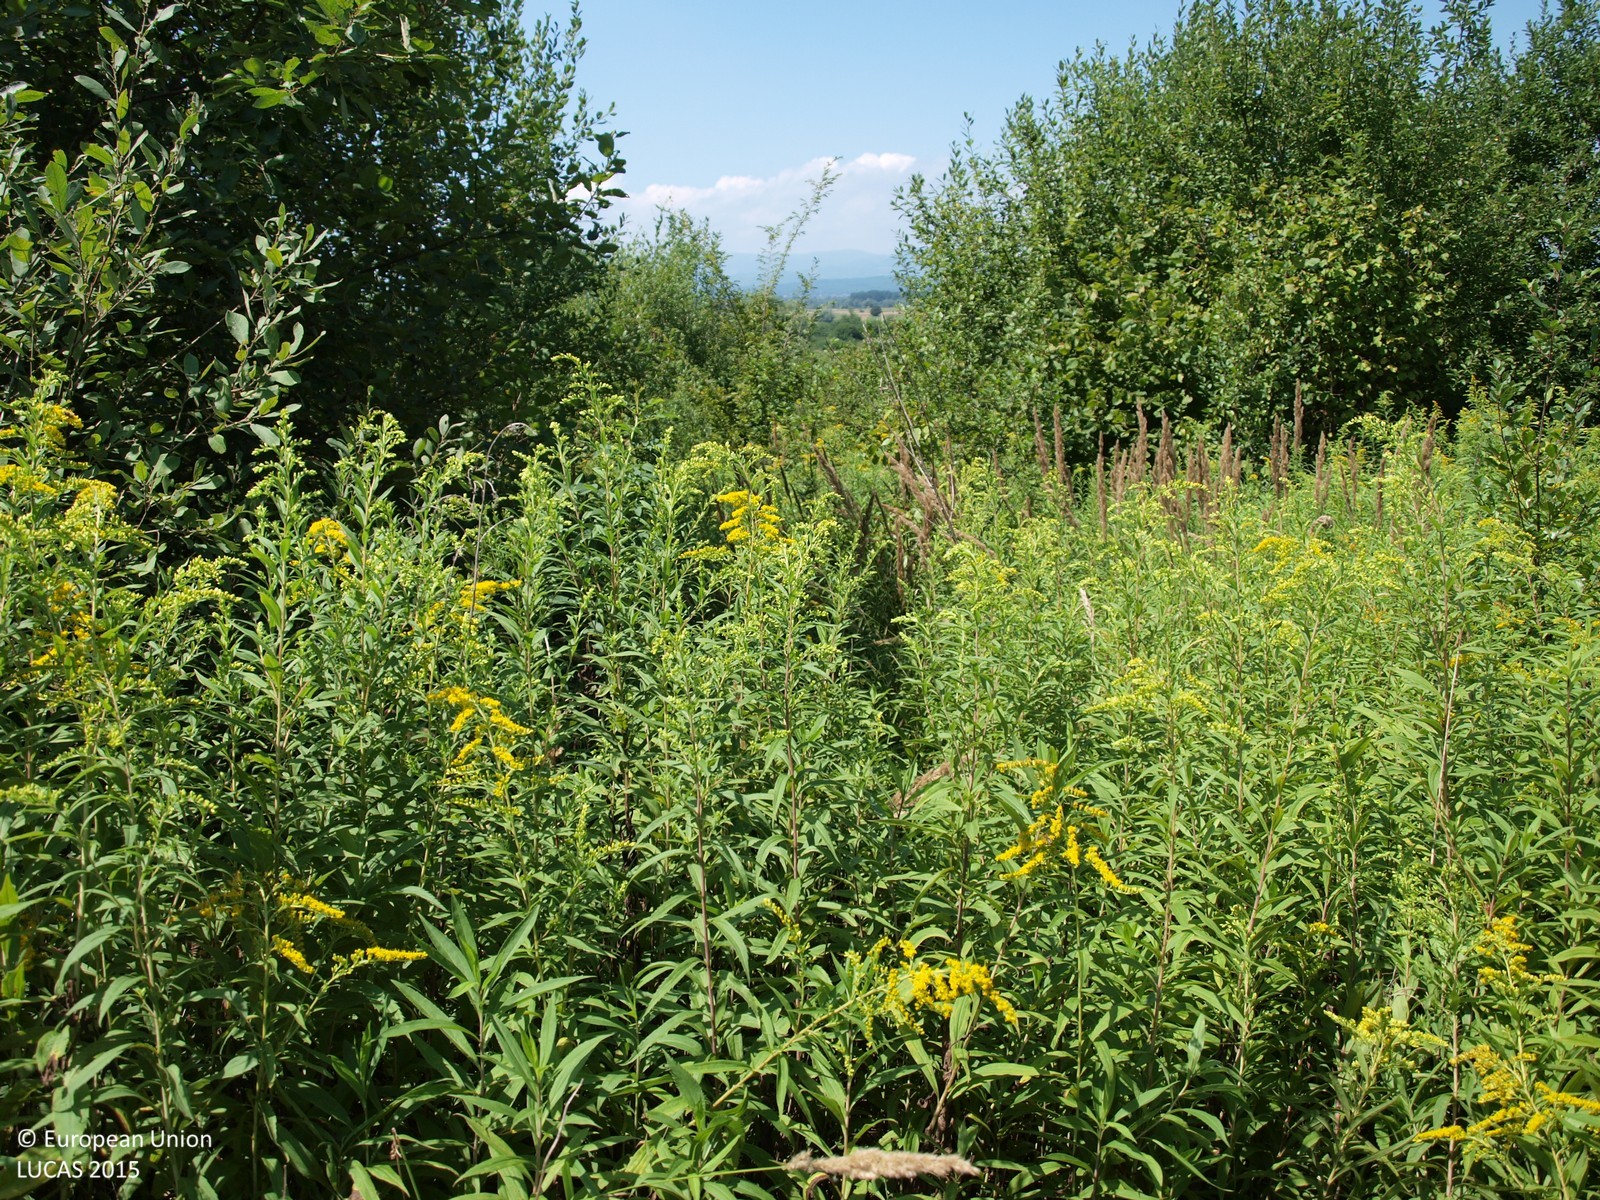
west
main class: Shrubland
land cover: Shrubland with sparse tree cover
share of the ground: > 75 %
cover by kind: shrubs 95 %, broadleaved forest trees 5 %
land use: Abandoned areas
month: August
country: HR
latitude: 45.8616
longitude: 16.2456
